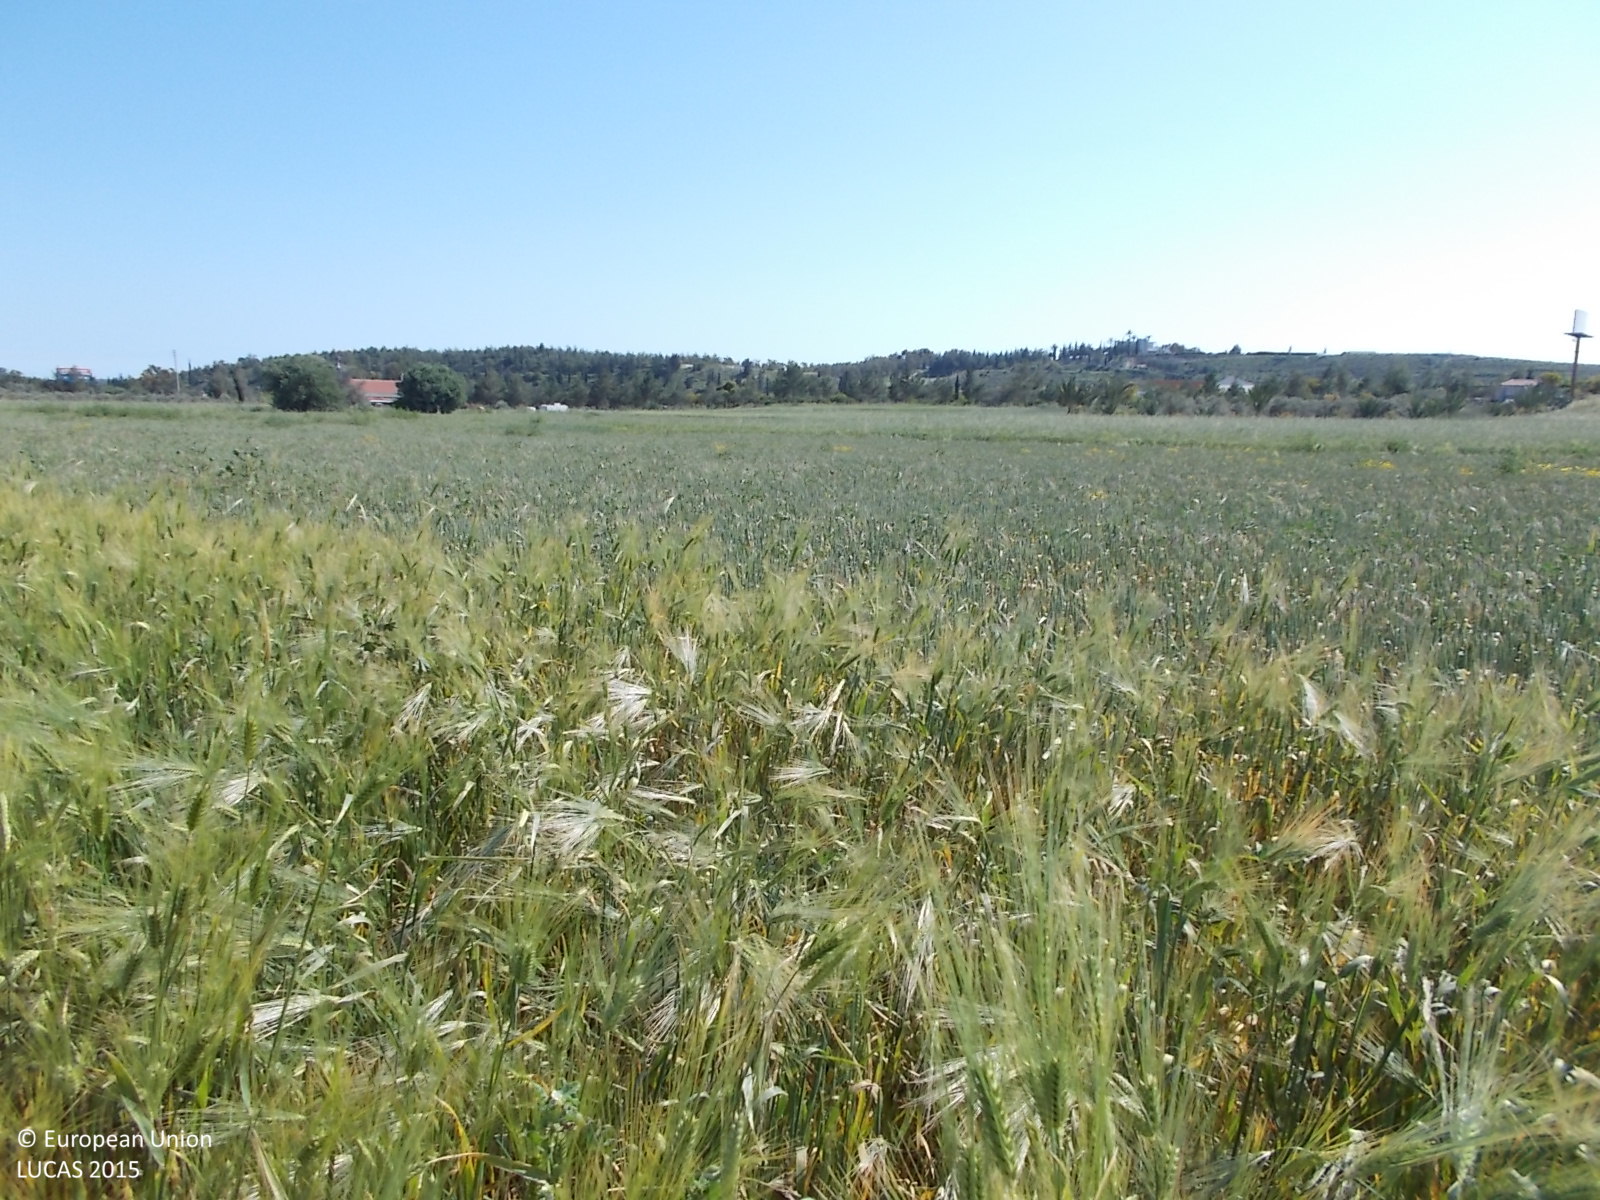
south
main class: Cropland
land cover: Barley
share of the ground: > 75 %
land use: Agriculture (excluding fallow land and kitchen gardens)
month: April
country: CY
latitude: 34.9688
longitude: 33.5571
